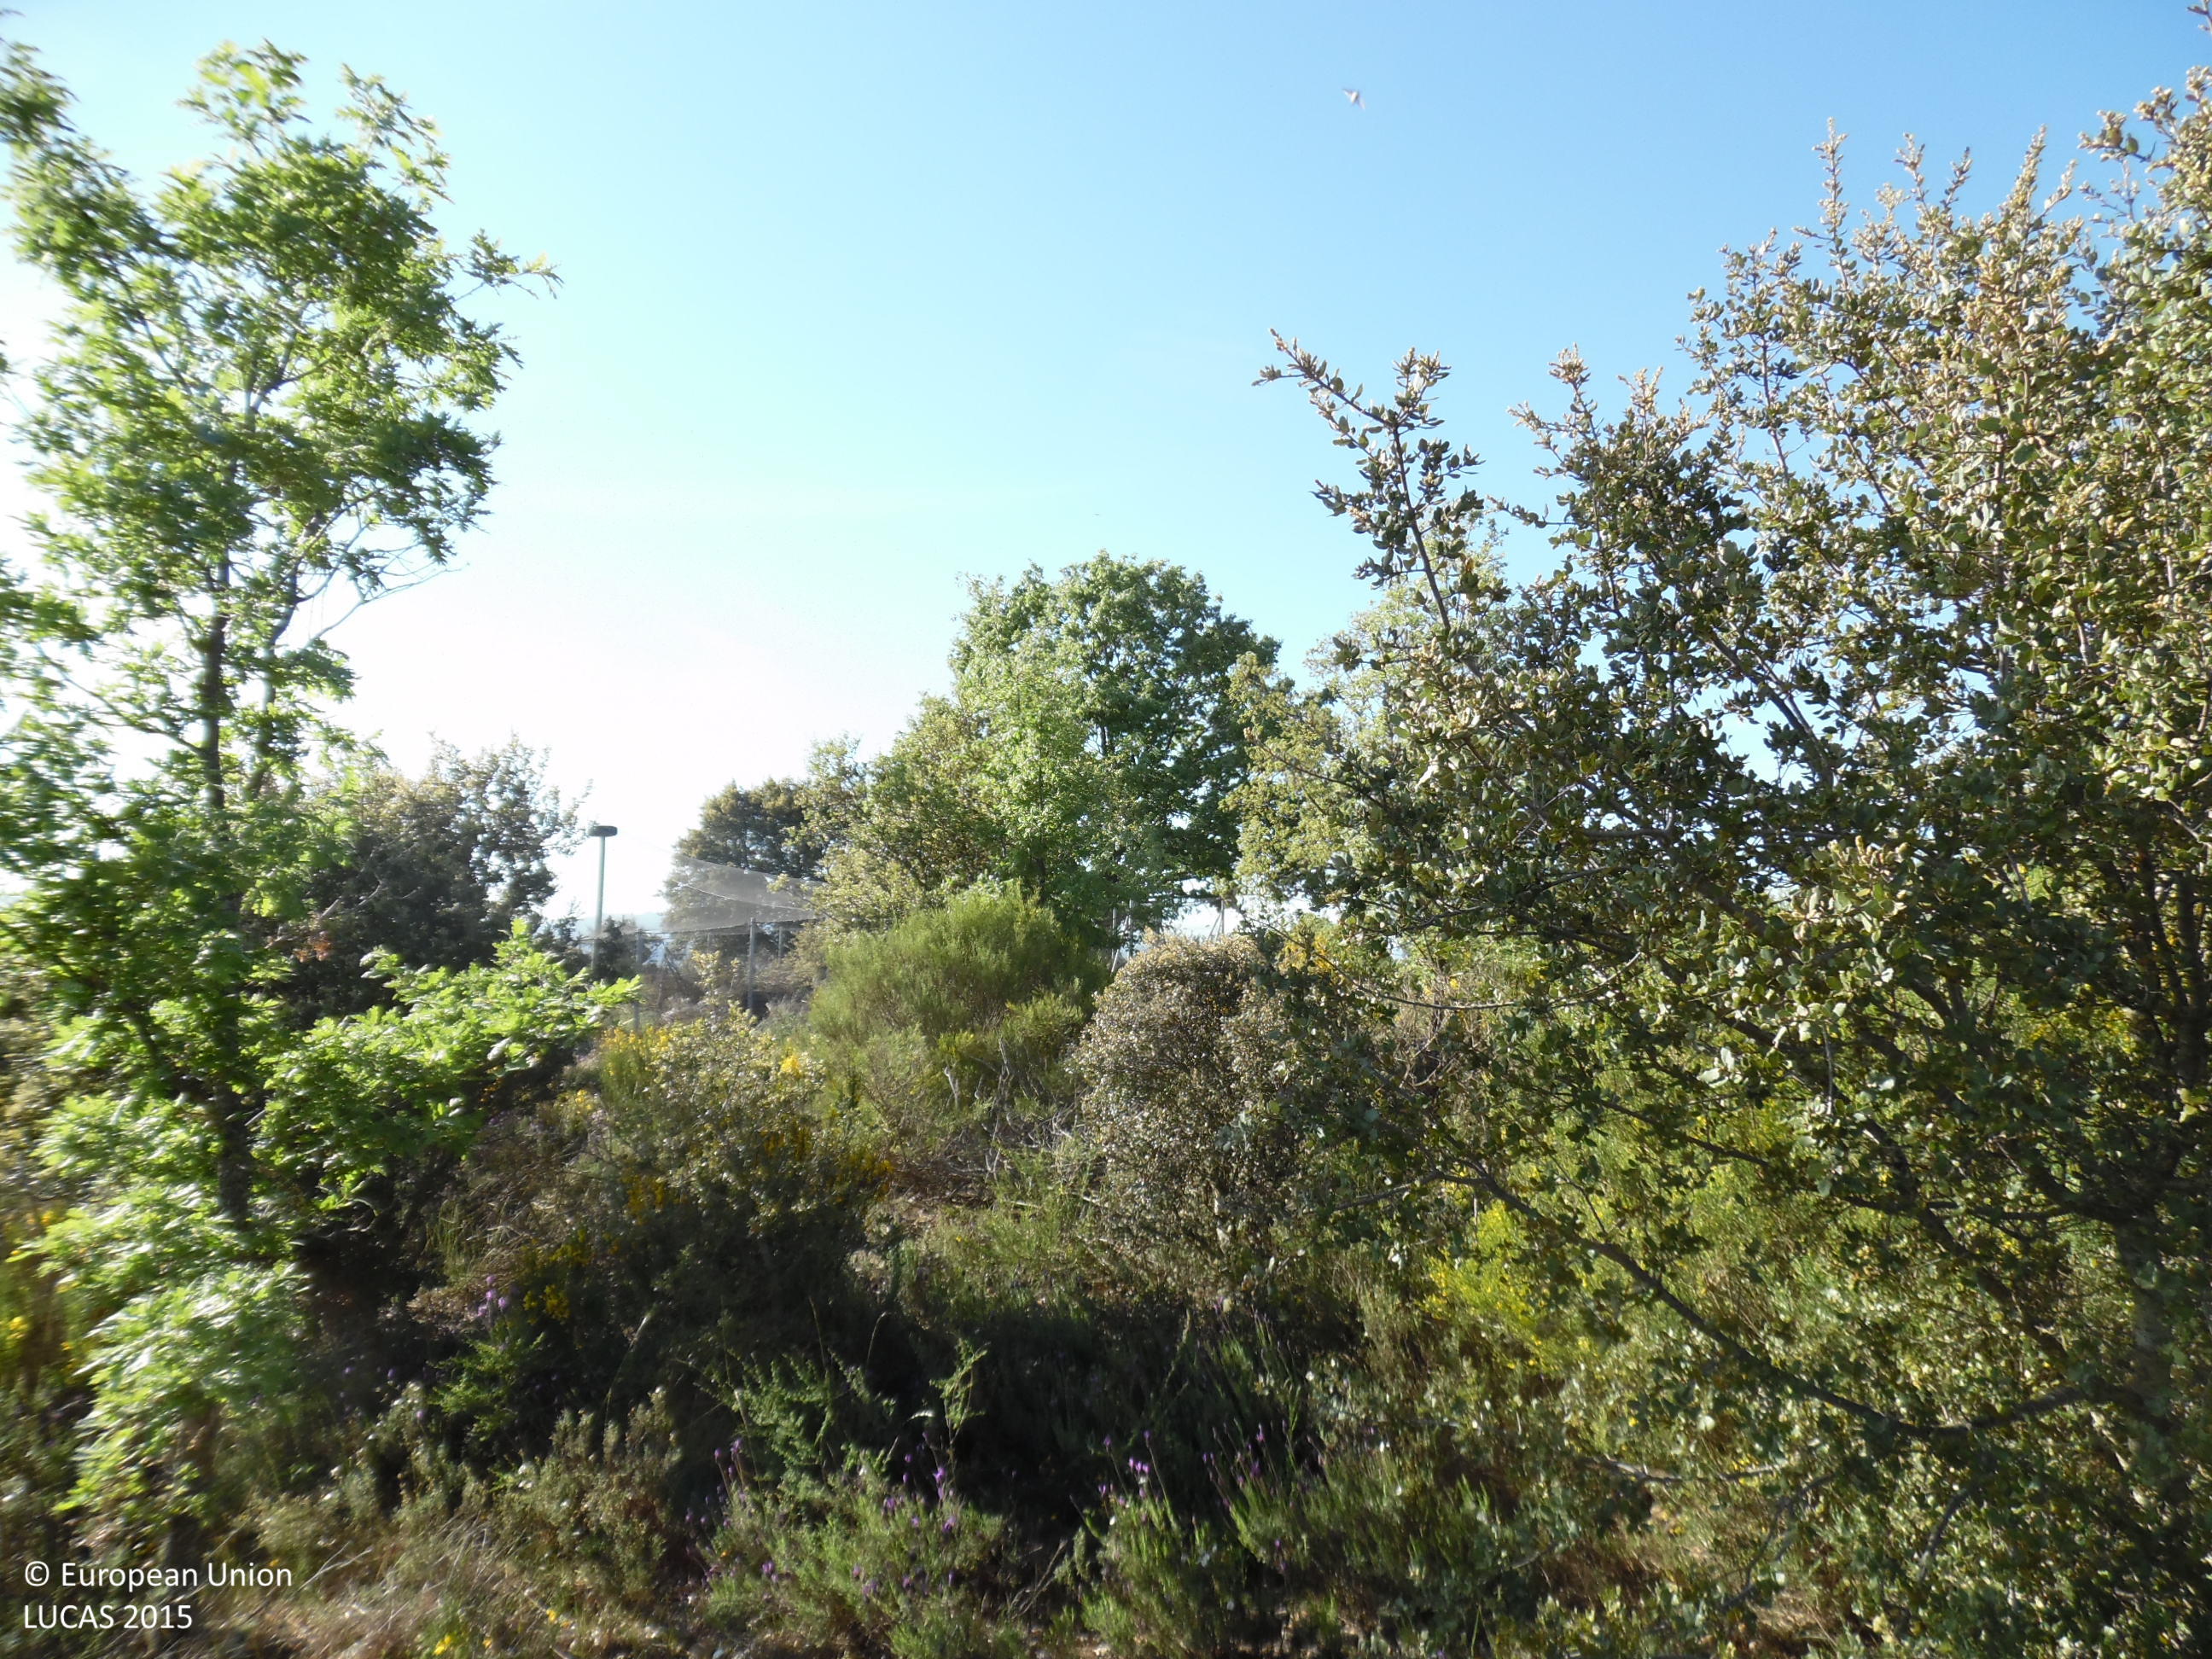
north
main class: Woodland
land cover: Broadleaved woodland
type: acidophilous oak and oak-birch forest
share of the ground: > 75 %
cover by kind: broadleaved forest trees 70 %, shrubs 20 %, herbaceous plants 10 %
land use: Abandoned areas
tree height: < 5 m
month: May
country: ES
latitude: 42.6180
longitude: -5.7925
